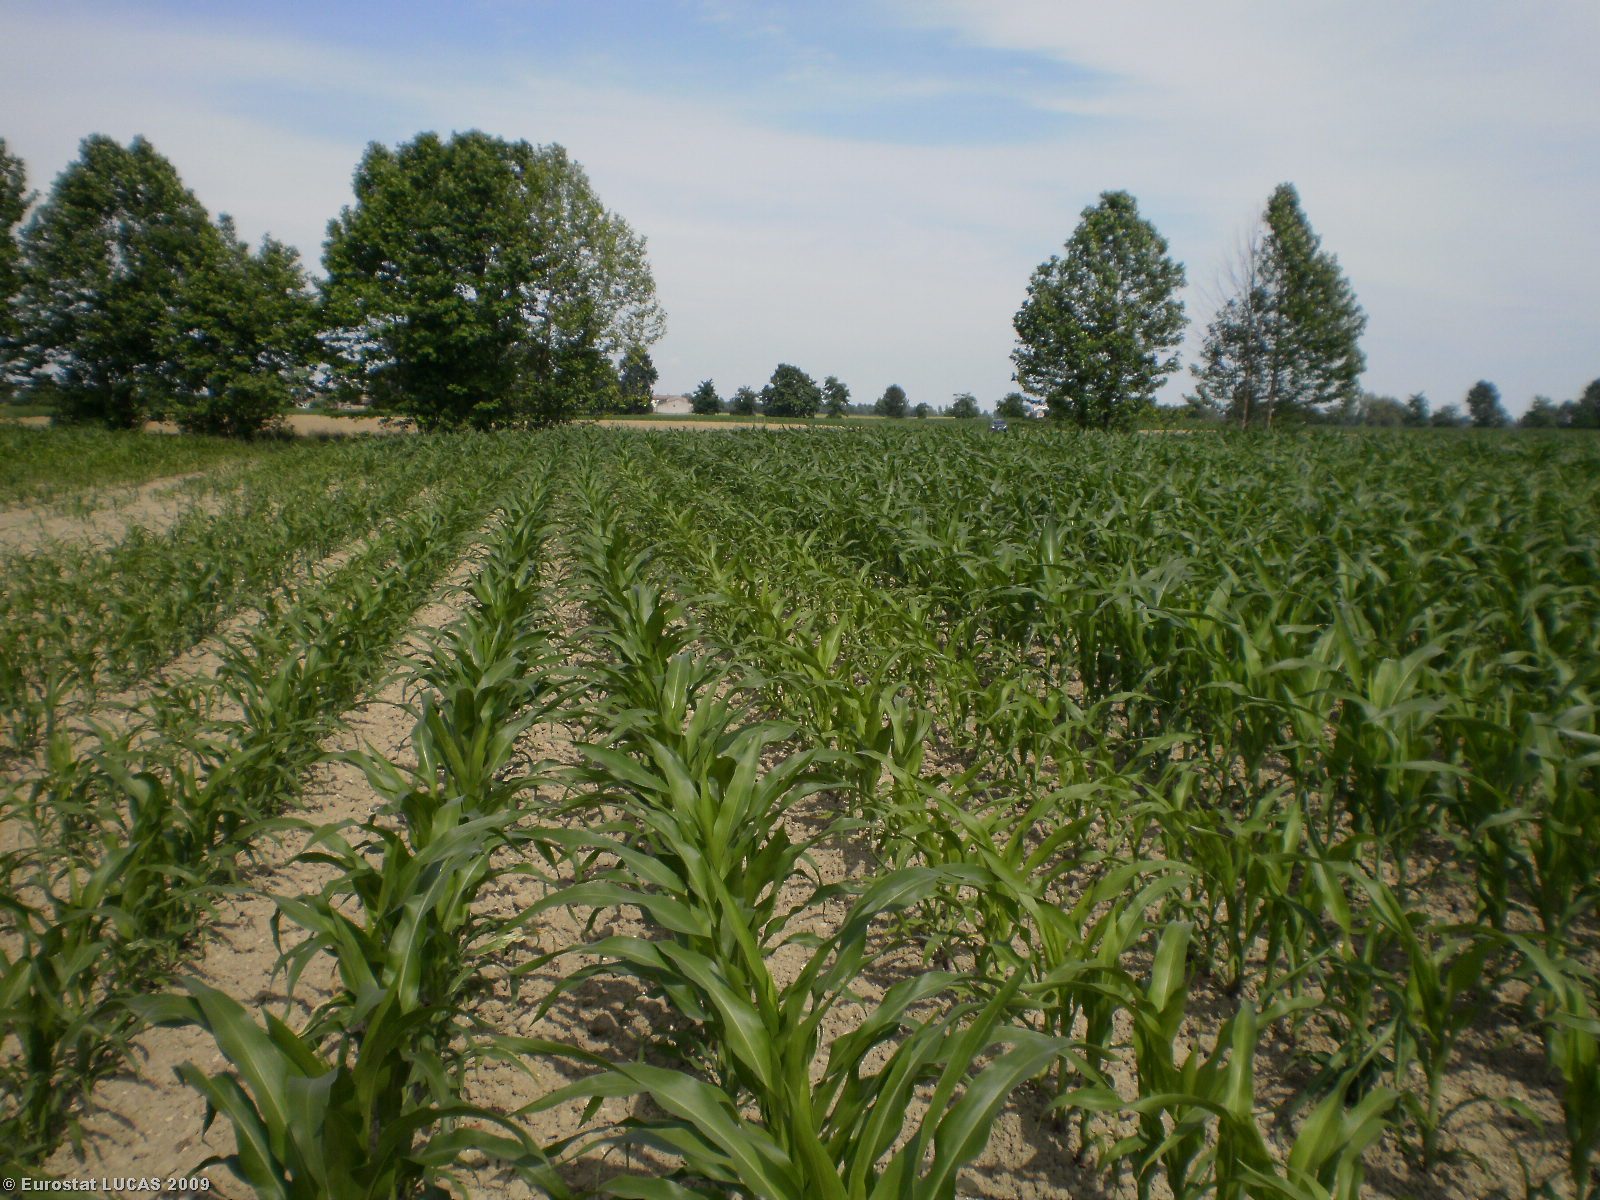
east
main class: Cropland
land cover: Maize
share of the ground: 50 - 75 %
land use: Agriculture (excluding fallow land and kitchen gardens)
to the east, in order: Maize; Grass margins; Ditches and canals; Abandoned hedges; Soya; Grass margins; Ditches and canals; Grass margins; Paved roads, cycling and walking lanes; Lucerne
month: May
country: IT
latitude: 45.2331
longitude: 10.4450
